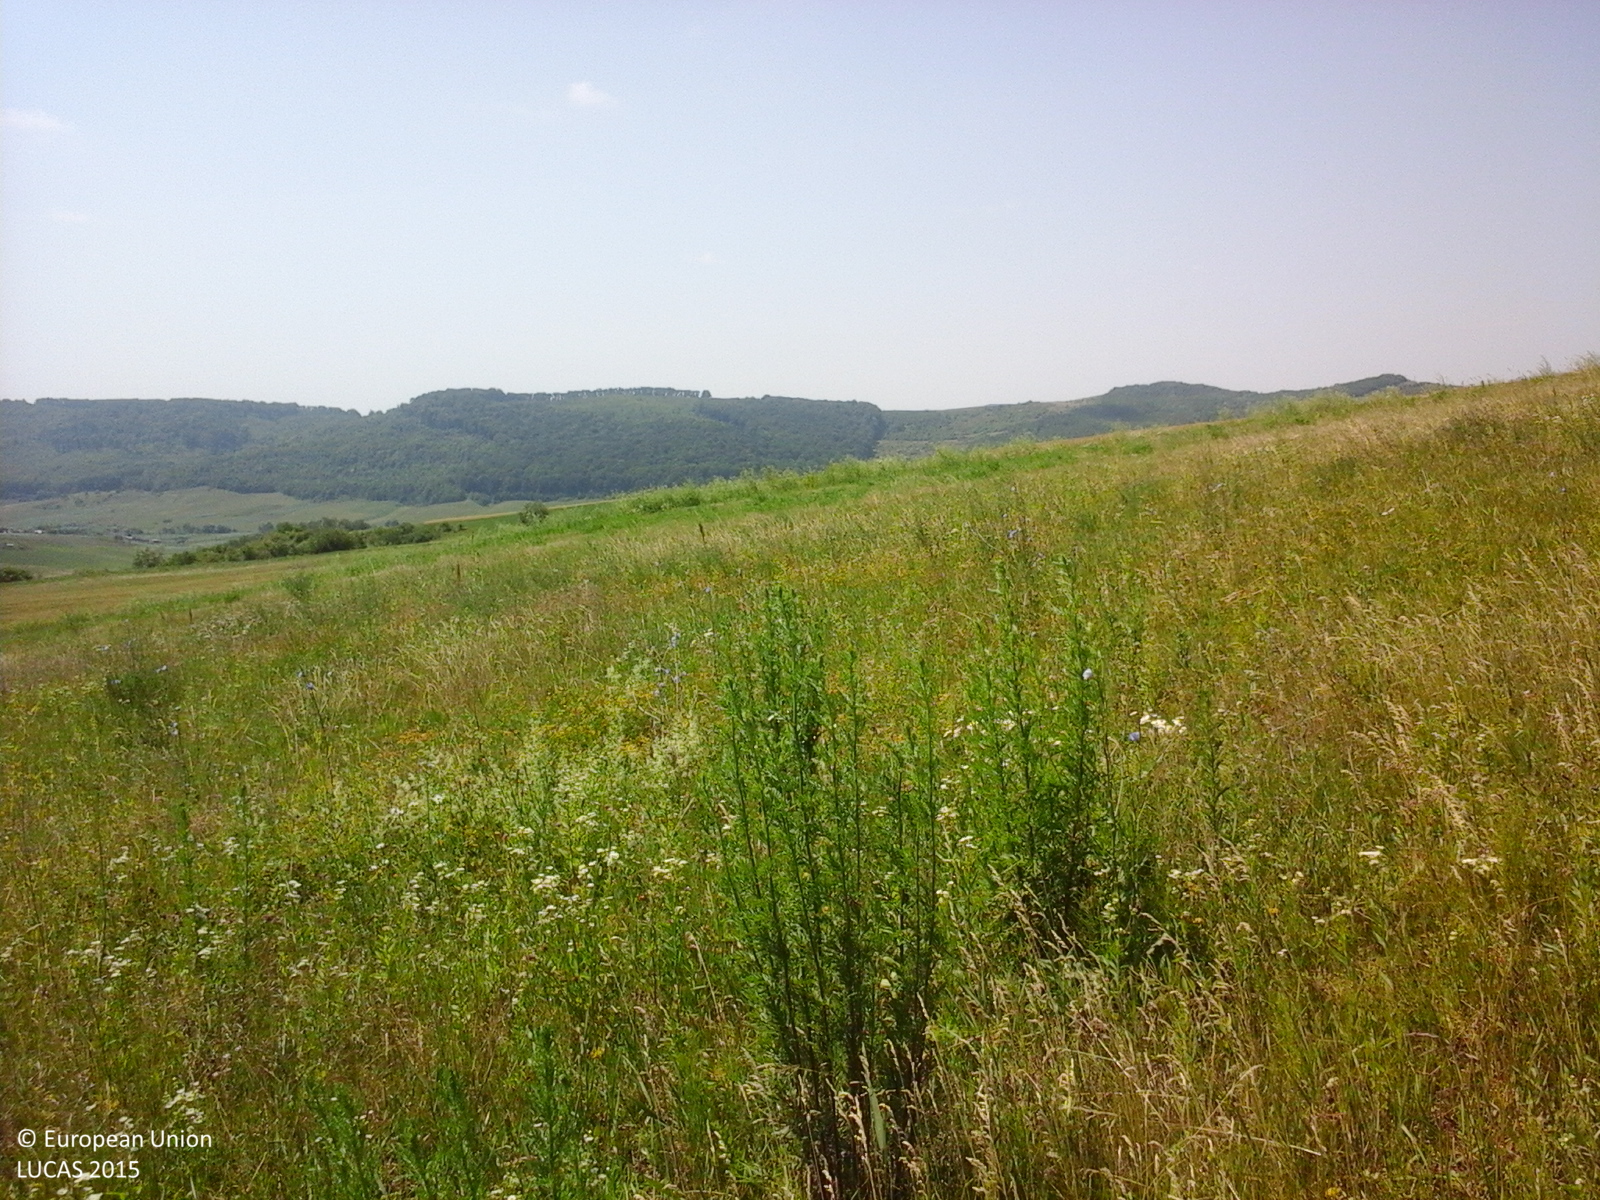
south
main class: Grassland
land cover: Grassland without tree/shrub cover
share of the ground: > 75 %
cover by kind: herbaceous plants 100 %
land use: Agriculture (excluding fallow land and kitchen gardens)
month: June
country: RO
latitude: 46.7199
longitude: 27.2569
